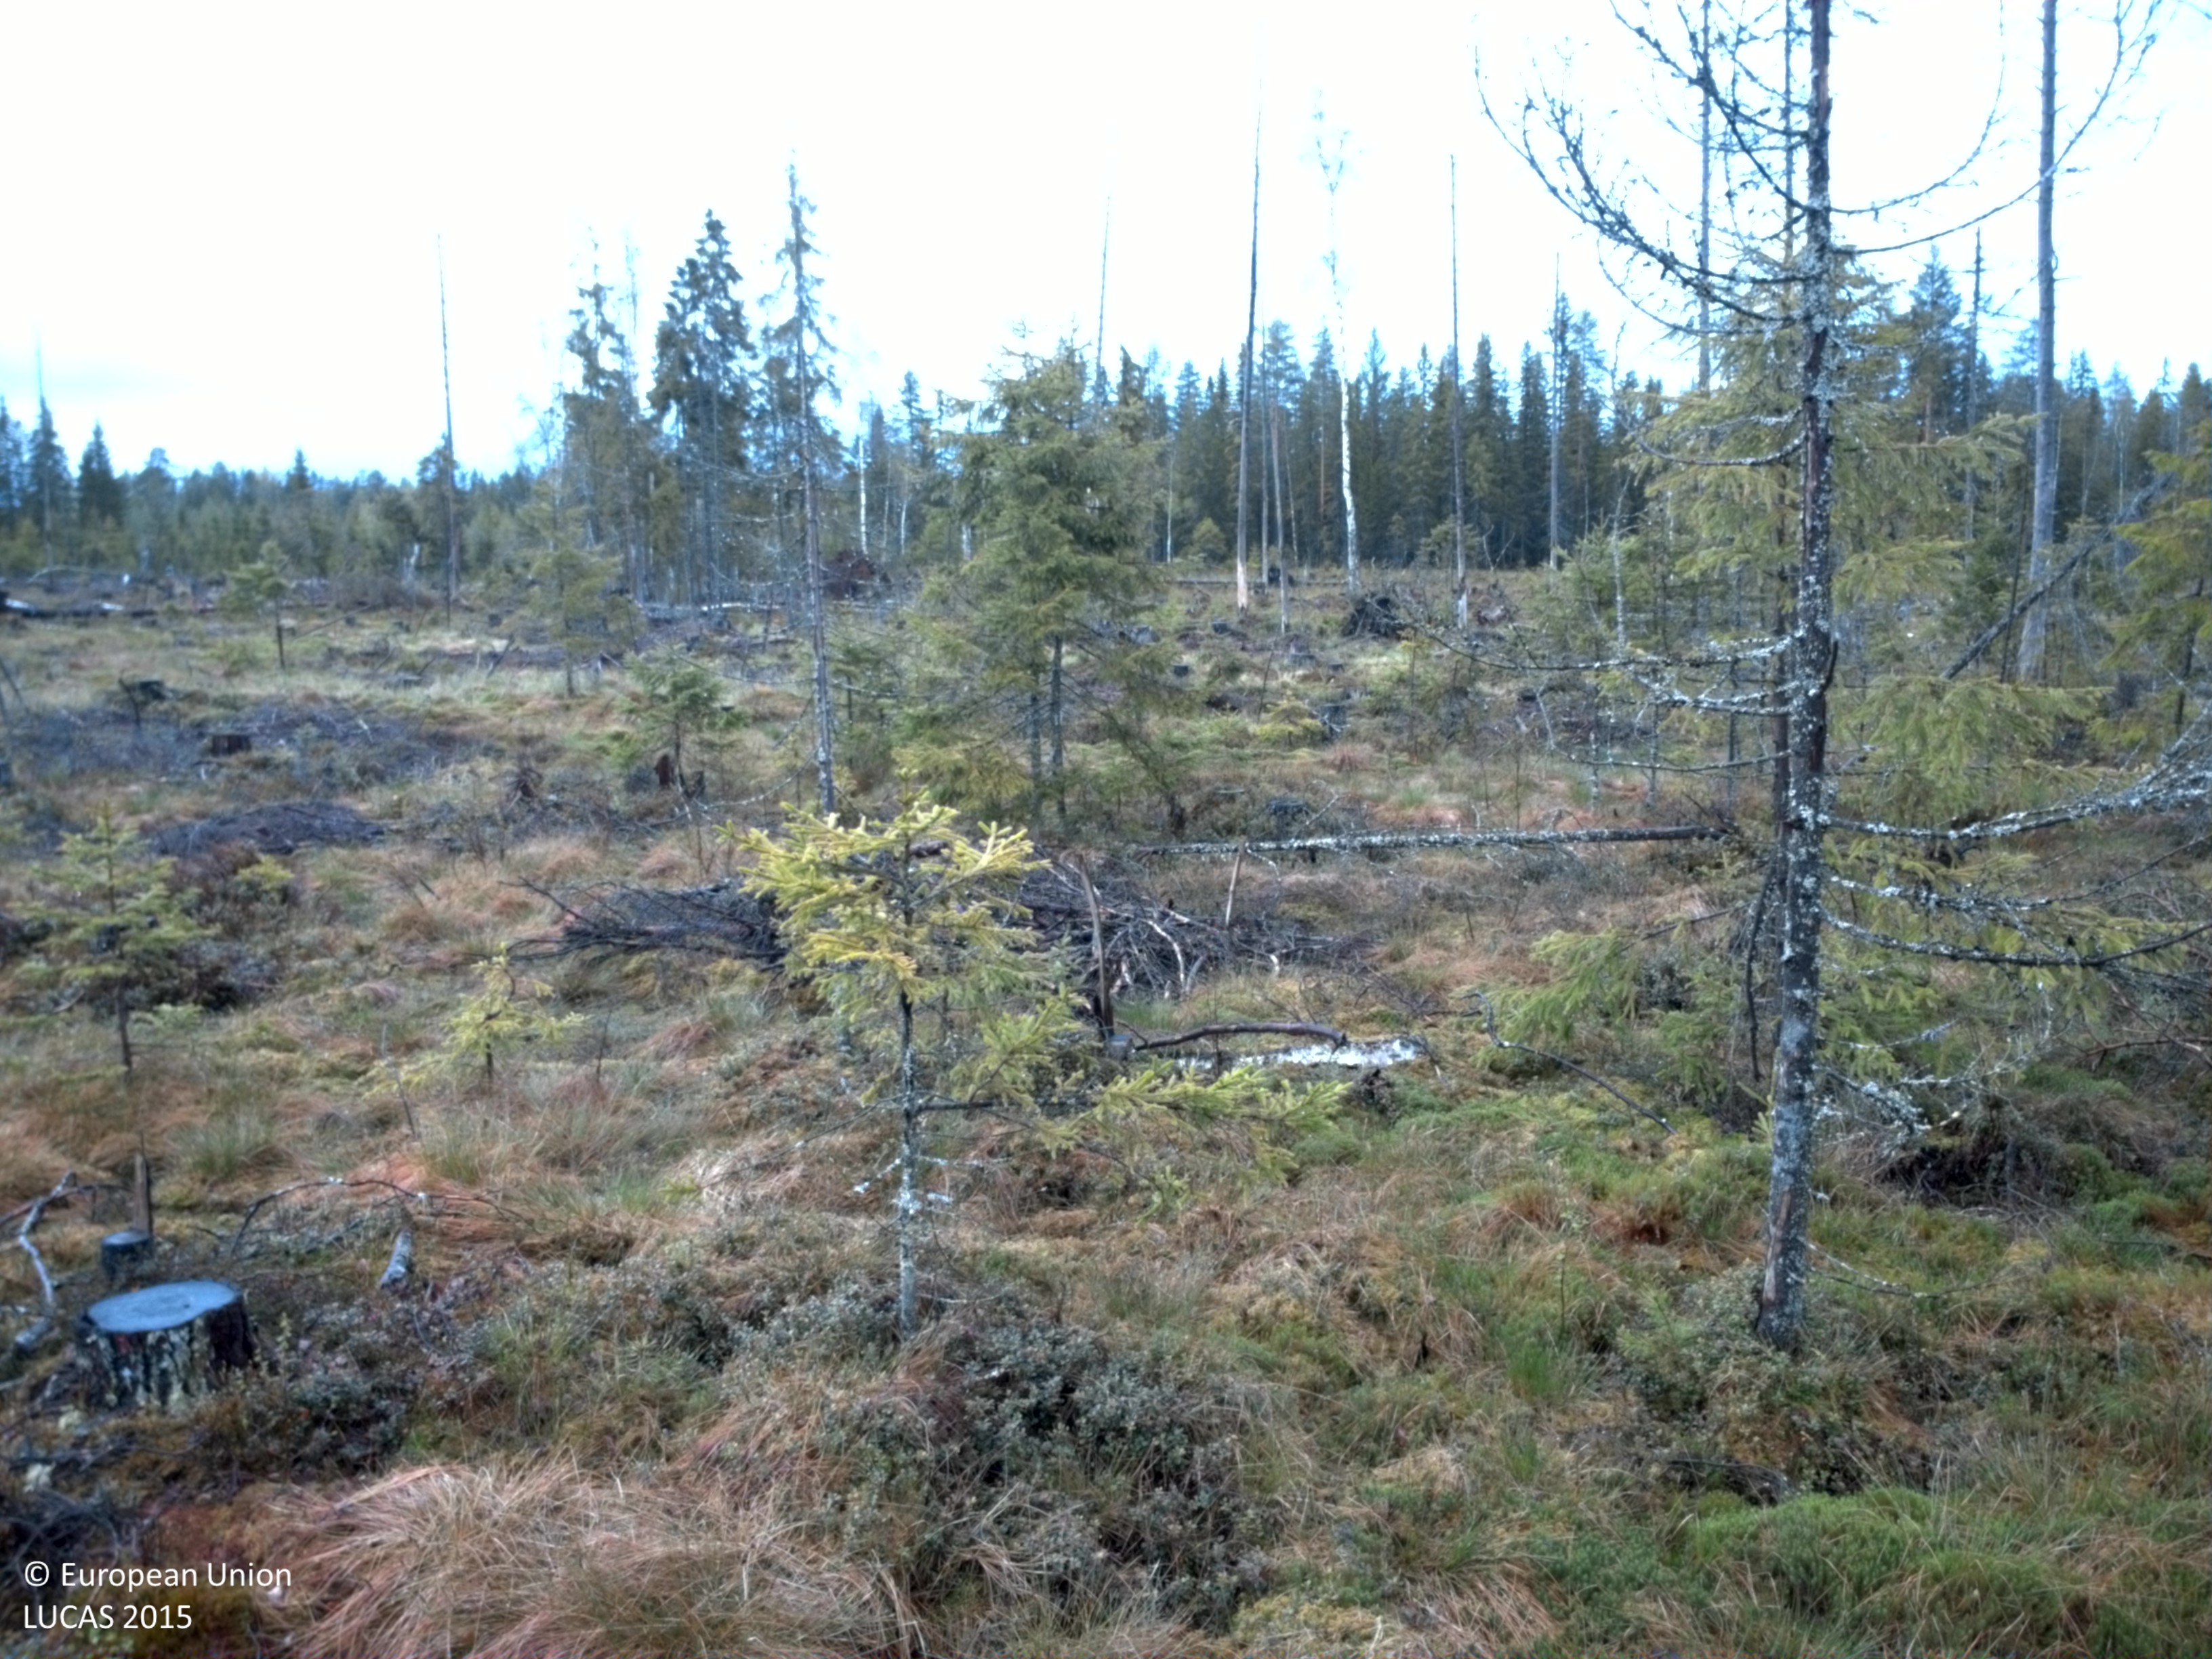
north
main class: Woodland
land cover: Spruce dominated mixed woodland
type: boreal forest
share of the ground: > 75 %
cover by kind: coniferous forest trees 55 %, broadleaved forest trees 25 %, herbaceous plants 10 %, shrubs 5 %, lichens and mosses 5 %
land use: Forestry
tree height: > 5 m
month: May
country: SE
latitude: 61.1444
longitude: 14.8339
